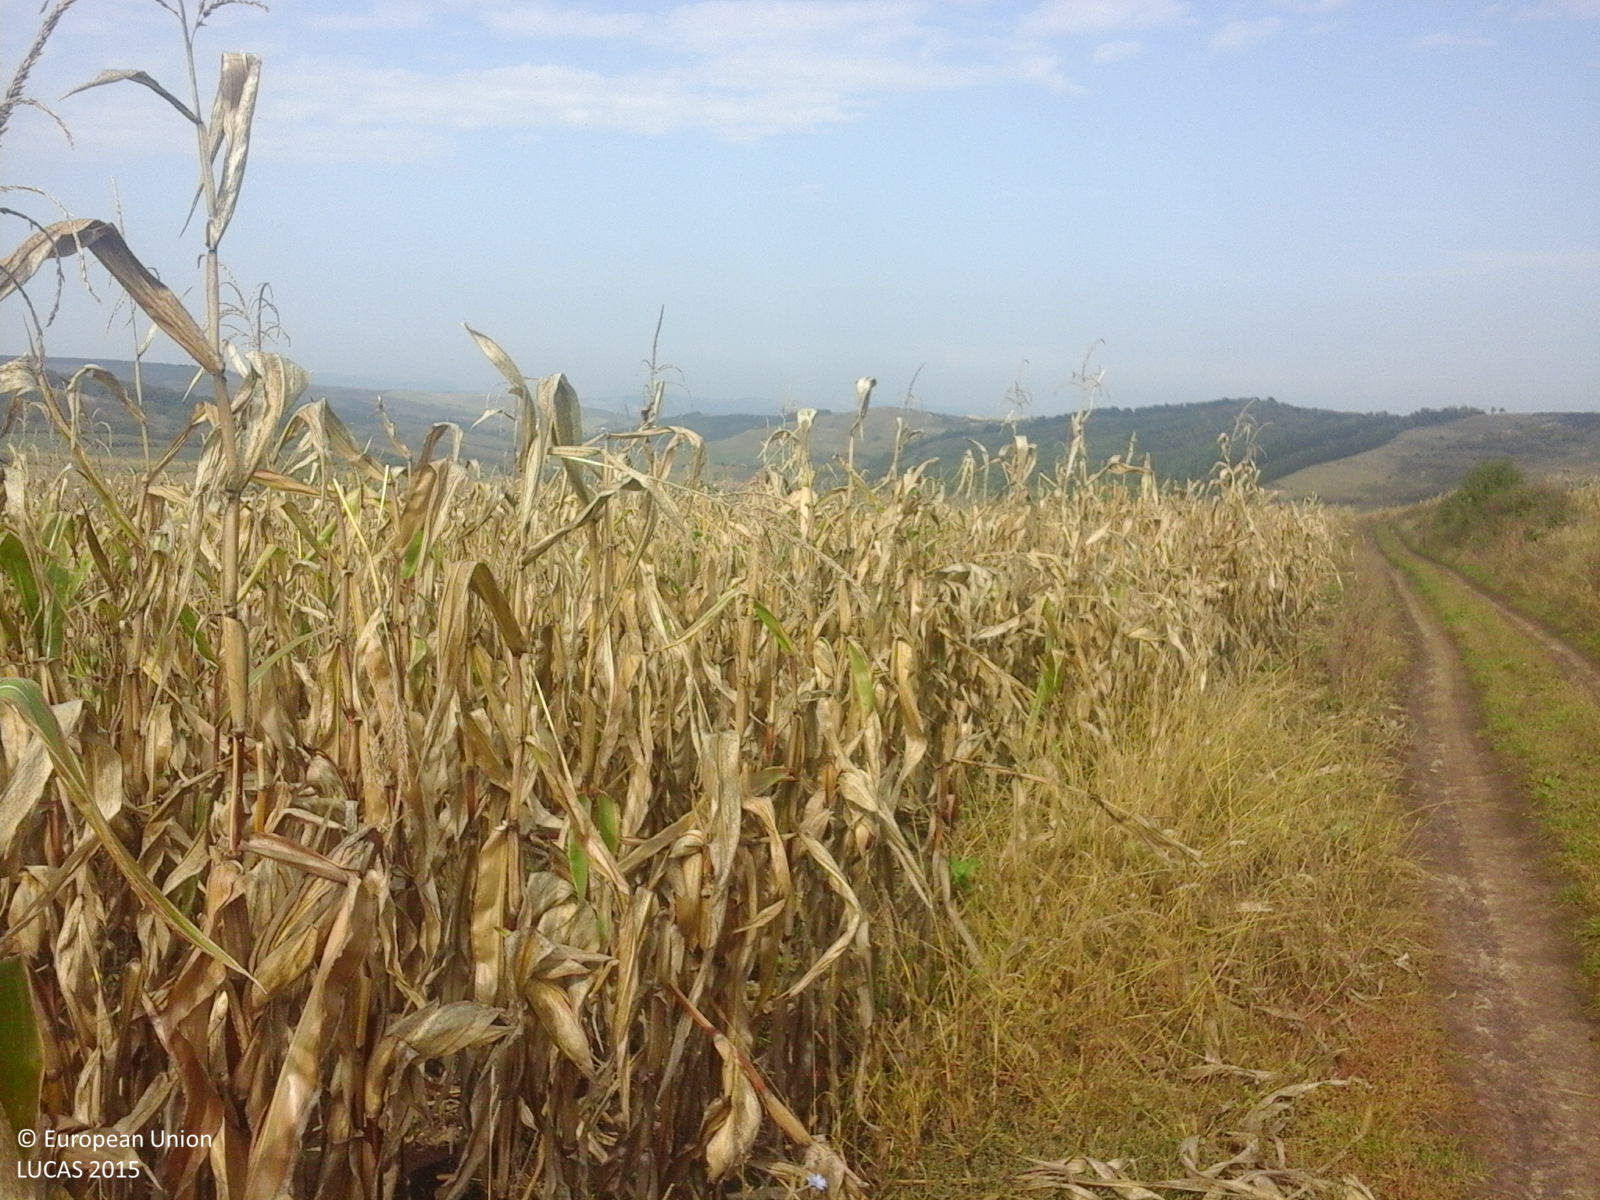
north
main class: Cropland
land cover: Maize
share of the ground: > 75 %
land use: Agriculture (excluding fallow land and kitchen gardens)
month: October
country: RO
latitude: 46.3692
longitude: 24.3162
